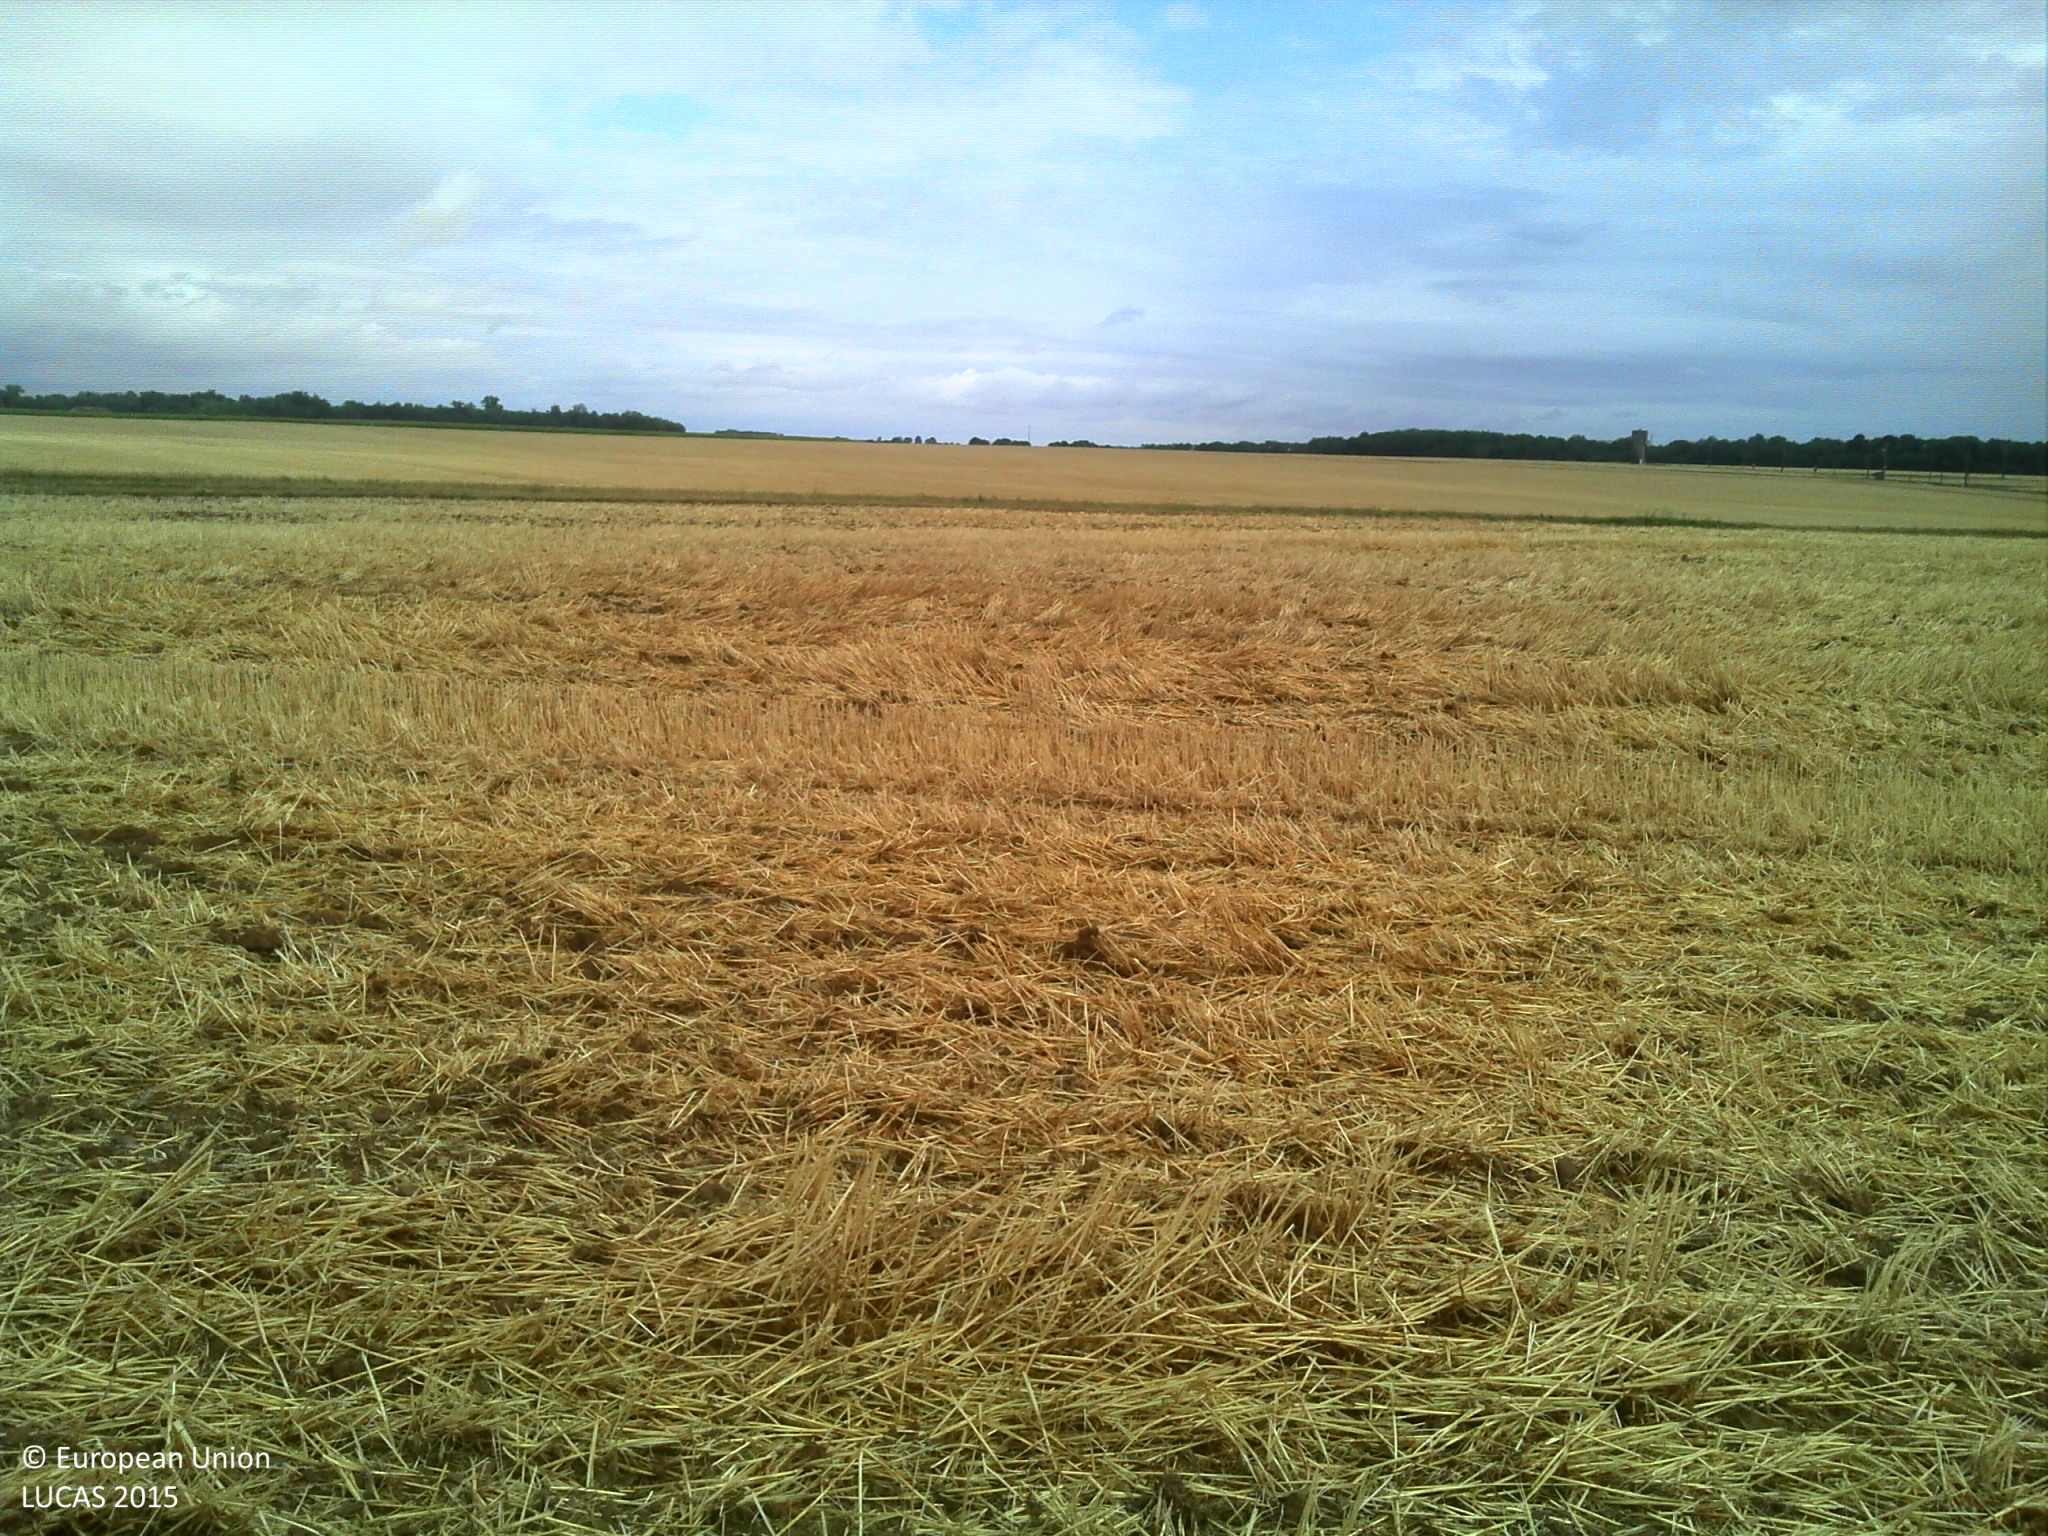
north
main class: Cropland
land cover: Common wheat
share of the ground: > 75 %
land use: Agriculture (excluding fallow land and kitchen gardens)
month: August
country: FR
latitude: 48.5832
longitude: 3.3645
